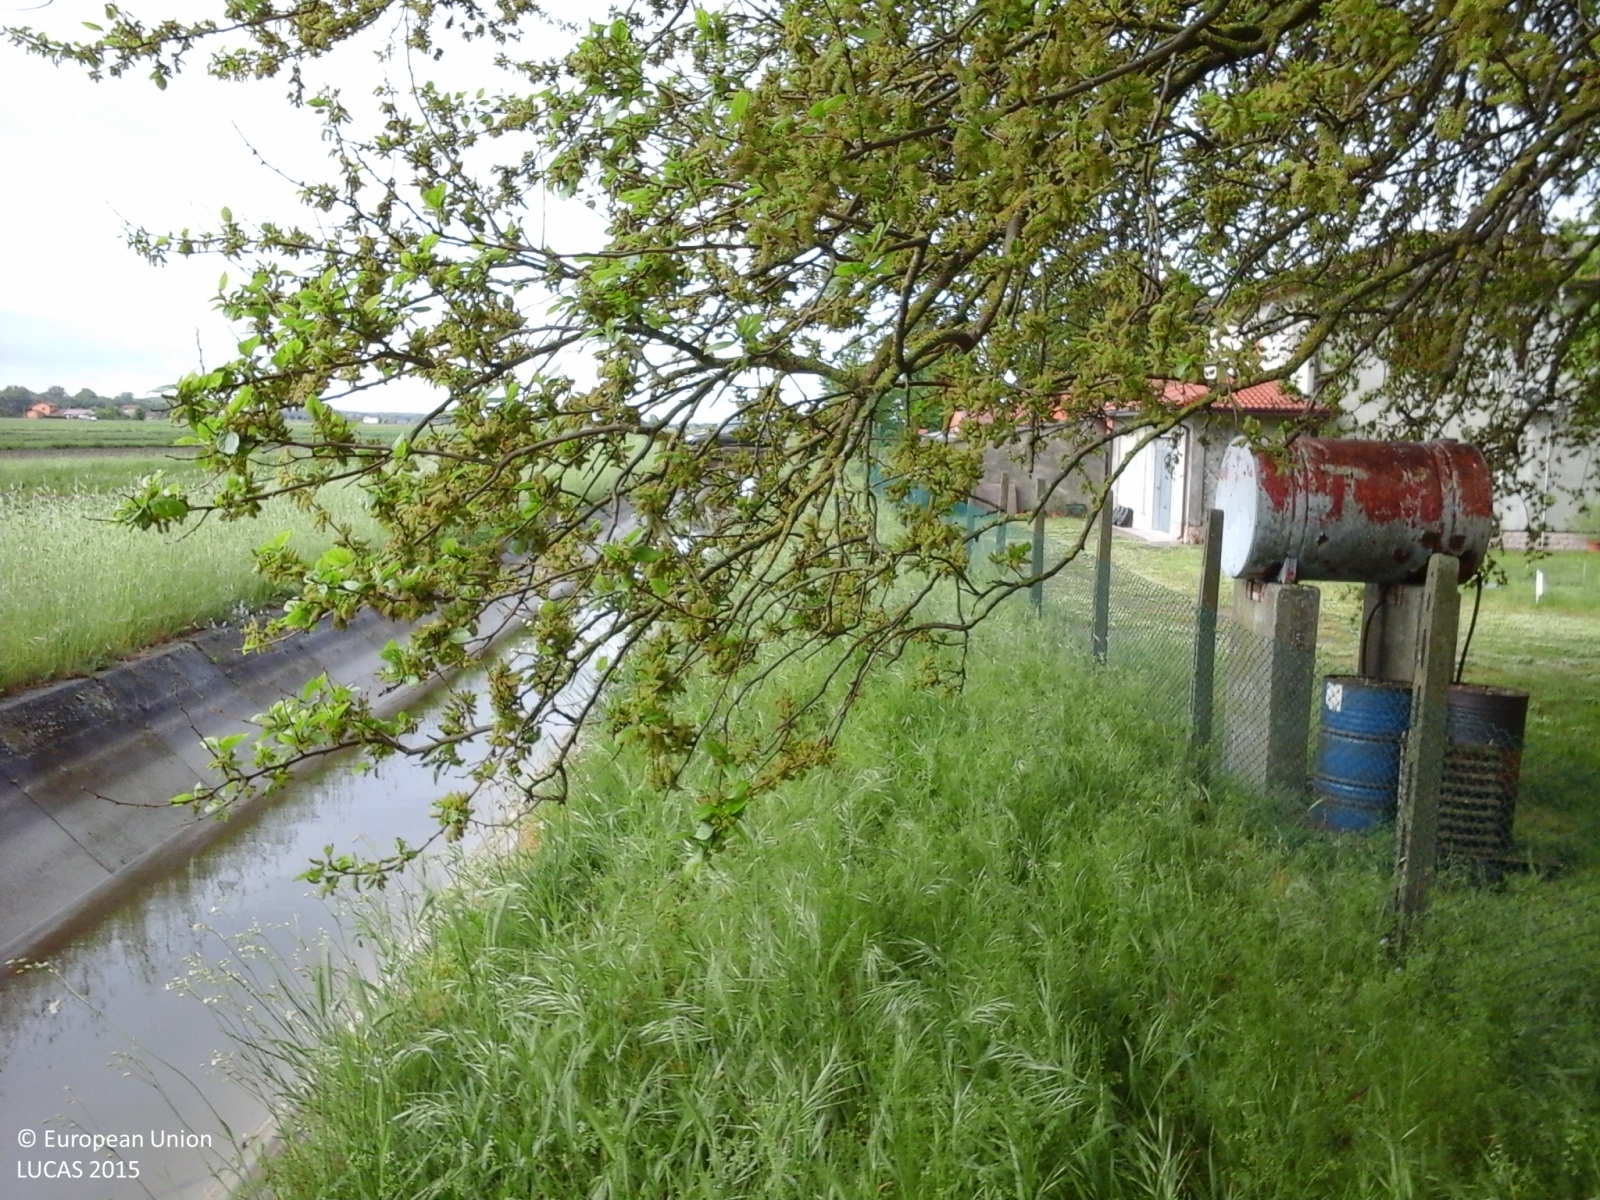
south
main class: Woodland
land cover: Broadleaved woodland
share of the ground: > 75 %
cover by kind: broadleaved forest trees 80 %, herbaceous plants 20 %
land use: Residential
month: April
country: IT
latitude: 44.8851
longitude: 12.2620
